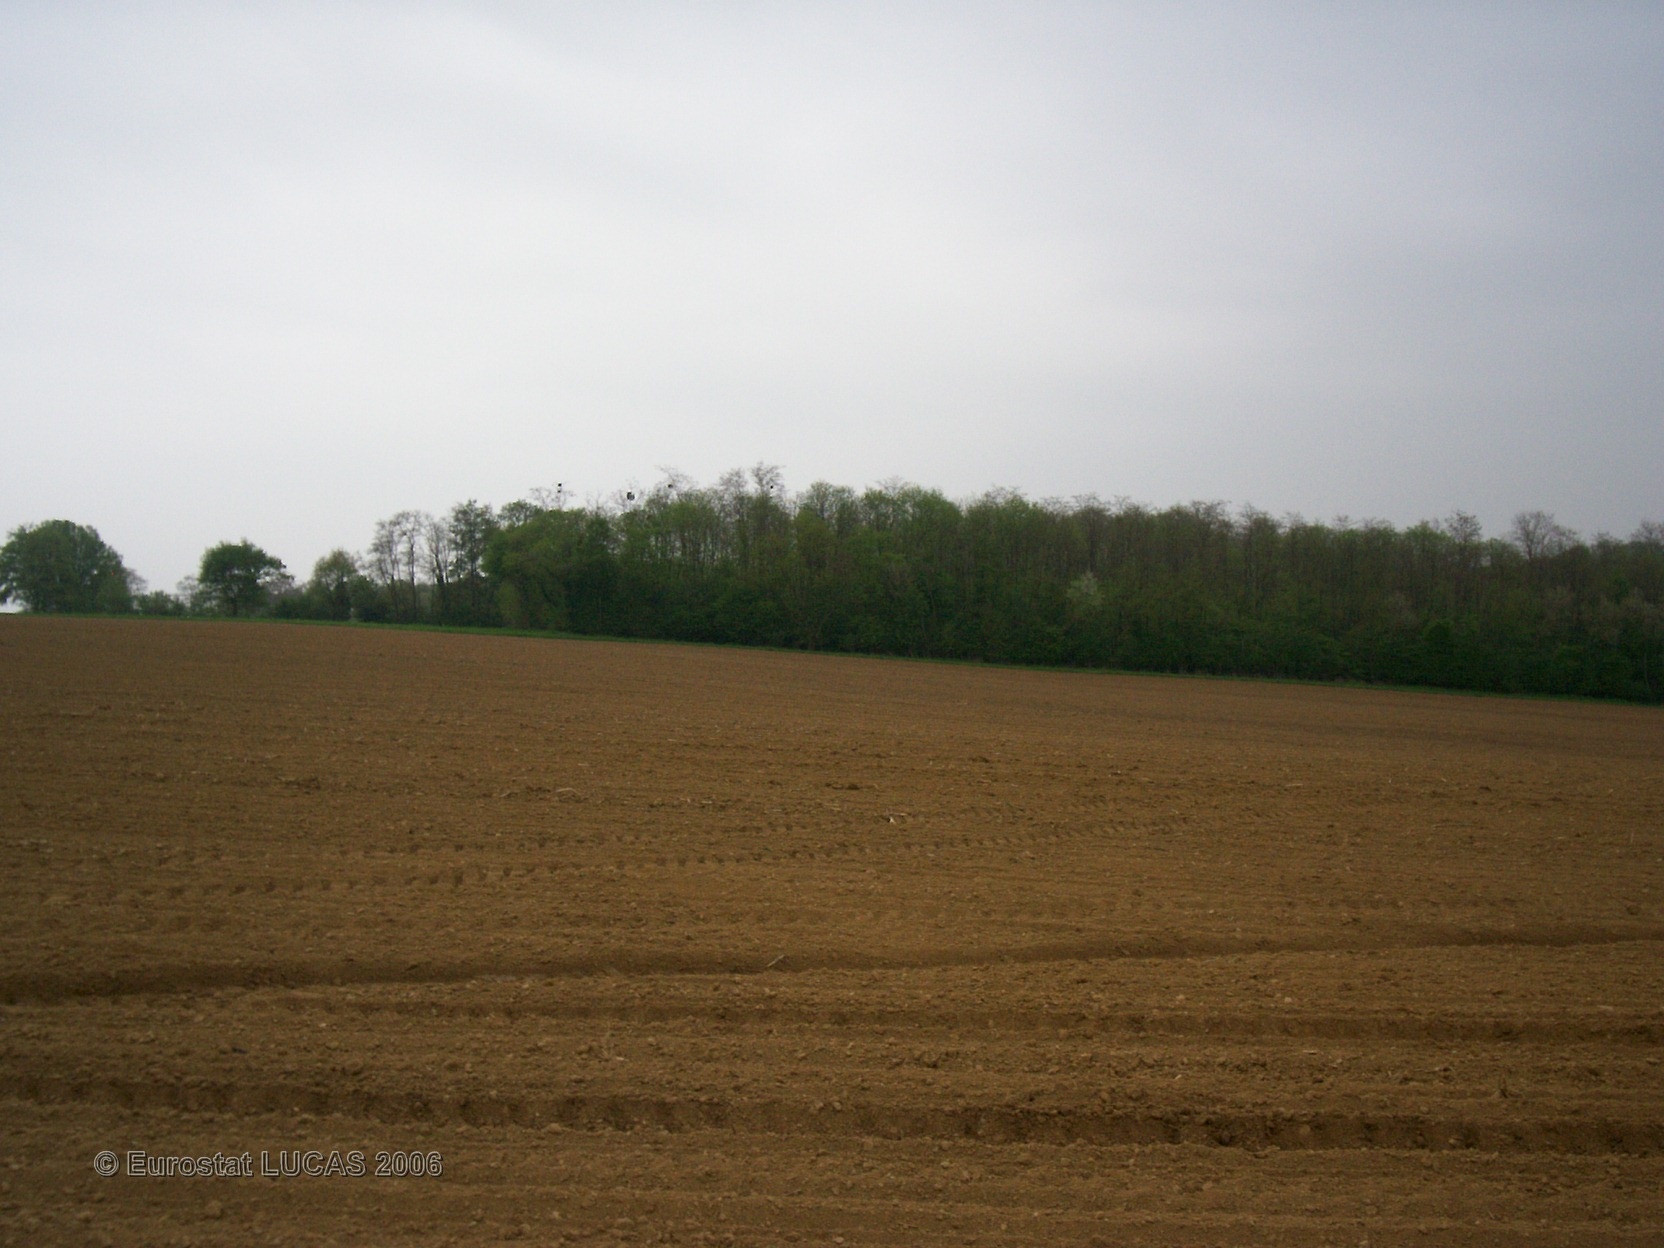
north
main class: Cropland
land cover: Maize
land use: Agriculture (excluding fallow land and kitchen gardens)
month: April
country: FR
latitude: 46.1196
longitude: 4.8654
